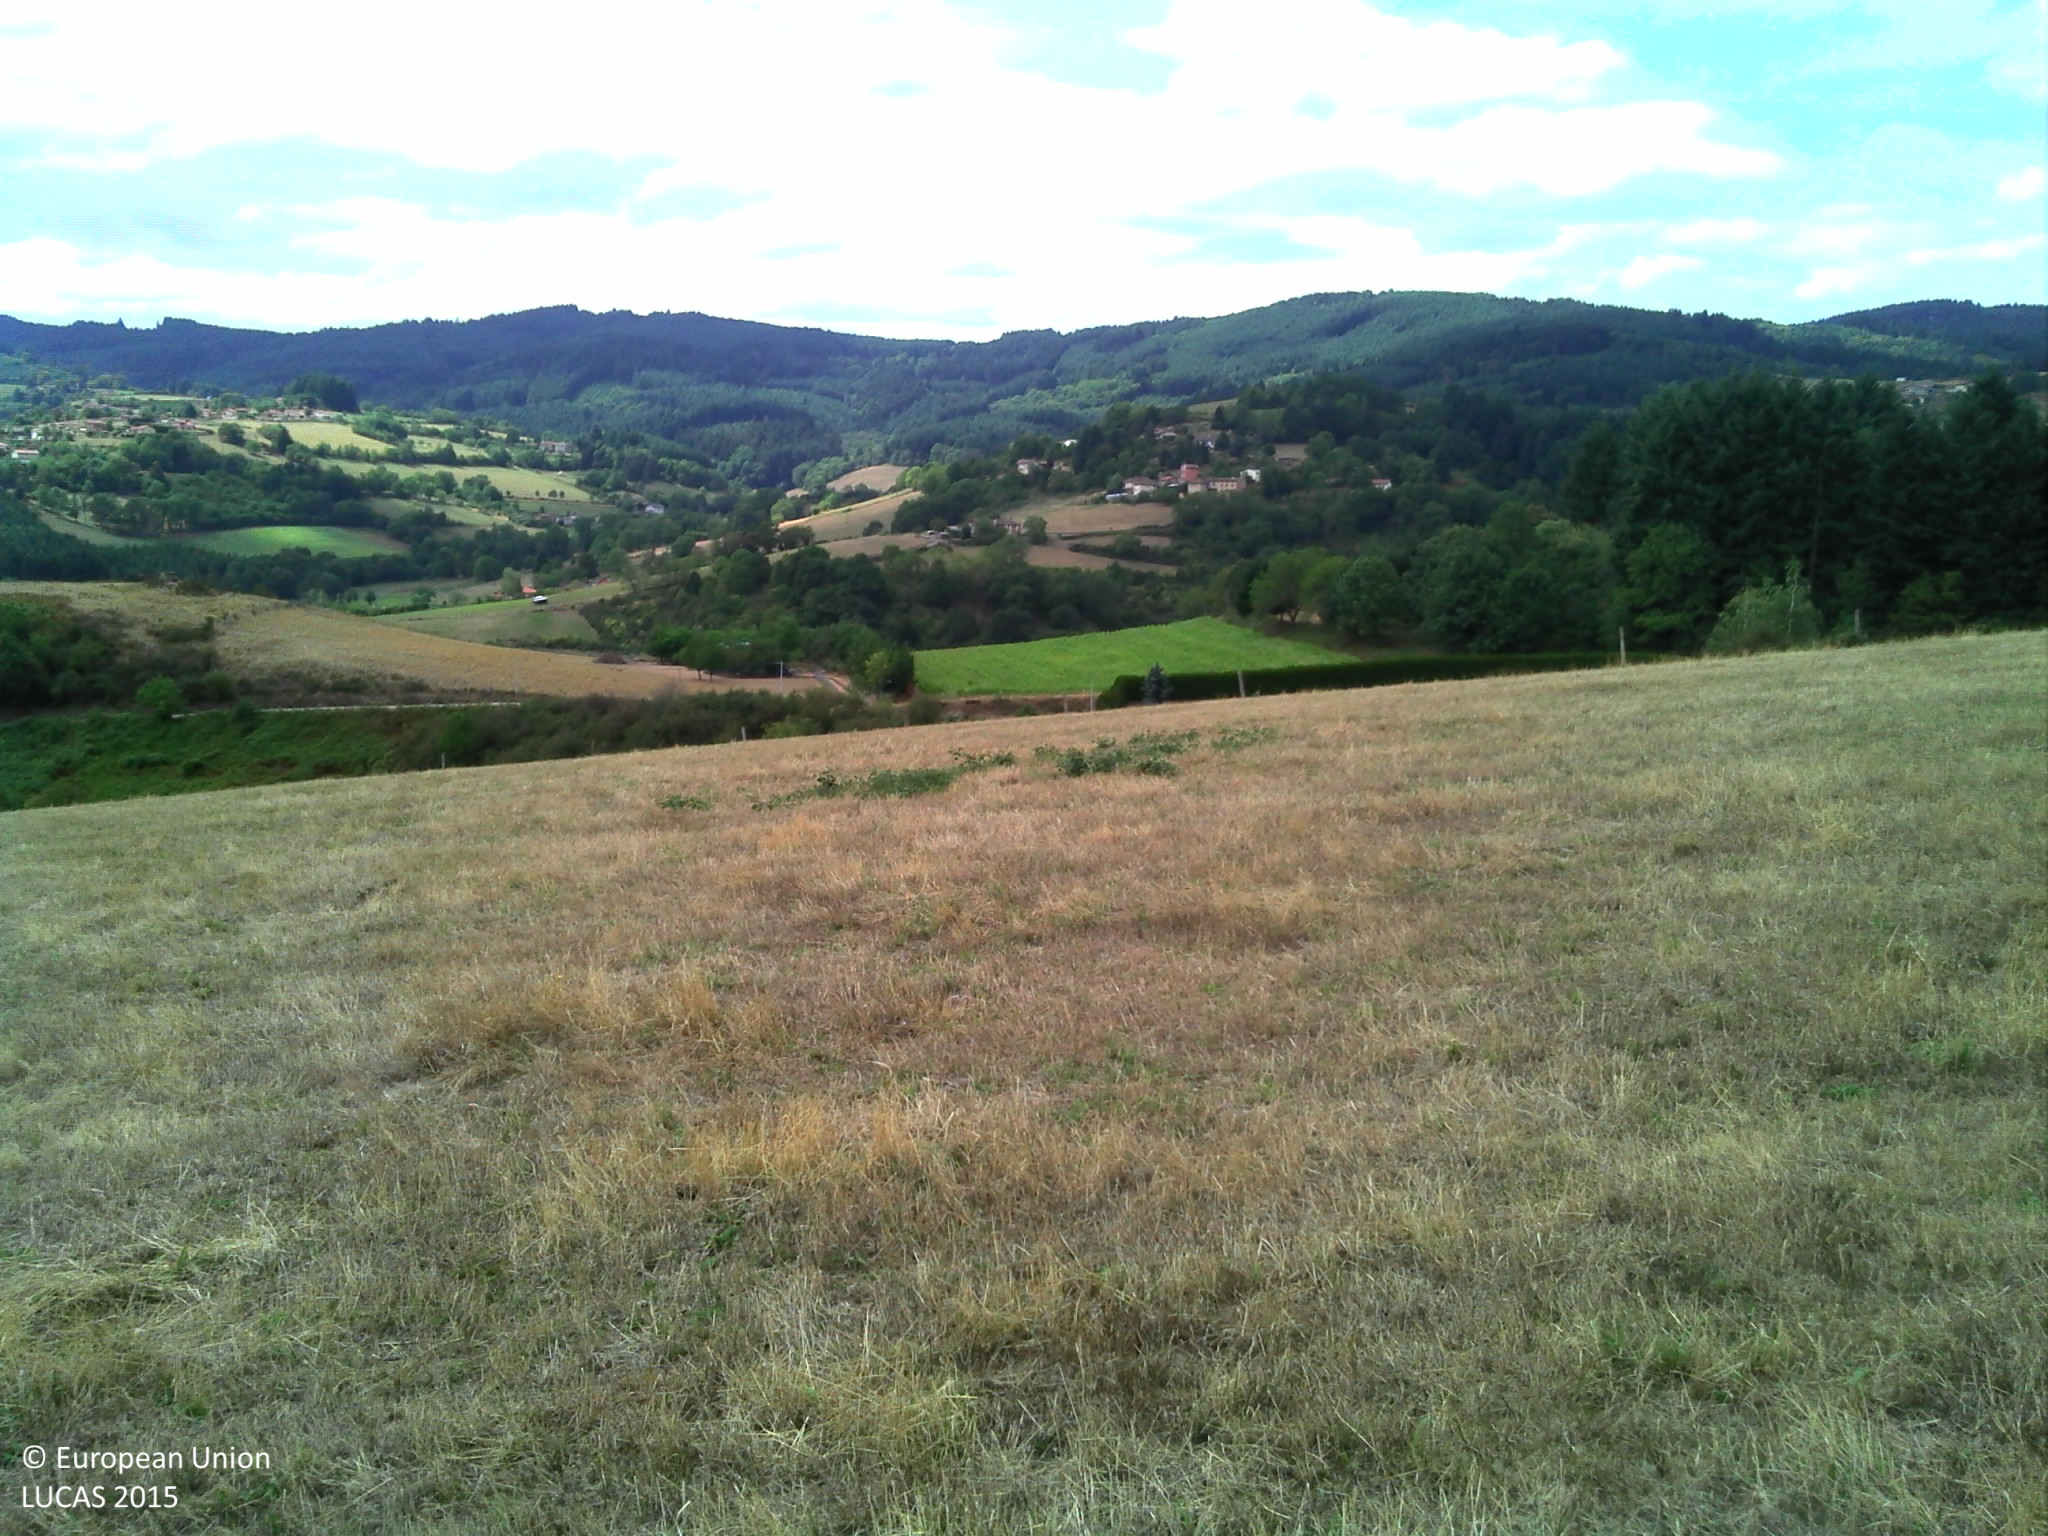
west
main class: Grassland
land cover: Grassland without tree/shrub cover
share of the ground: > 75 %
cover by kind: herbaceous plants 100 %
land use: Agriculture (excluding fallow land and kitchen gardens)
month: August
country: FR
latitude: 46.0092
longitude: 4.4621
